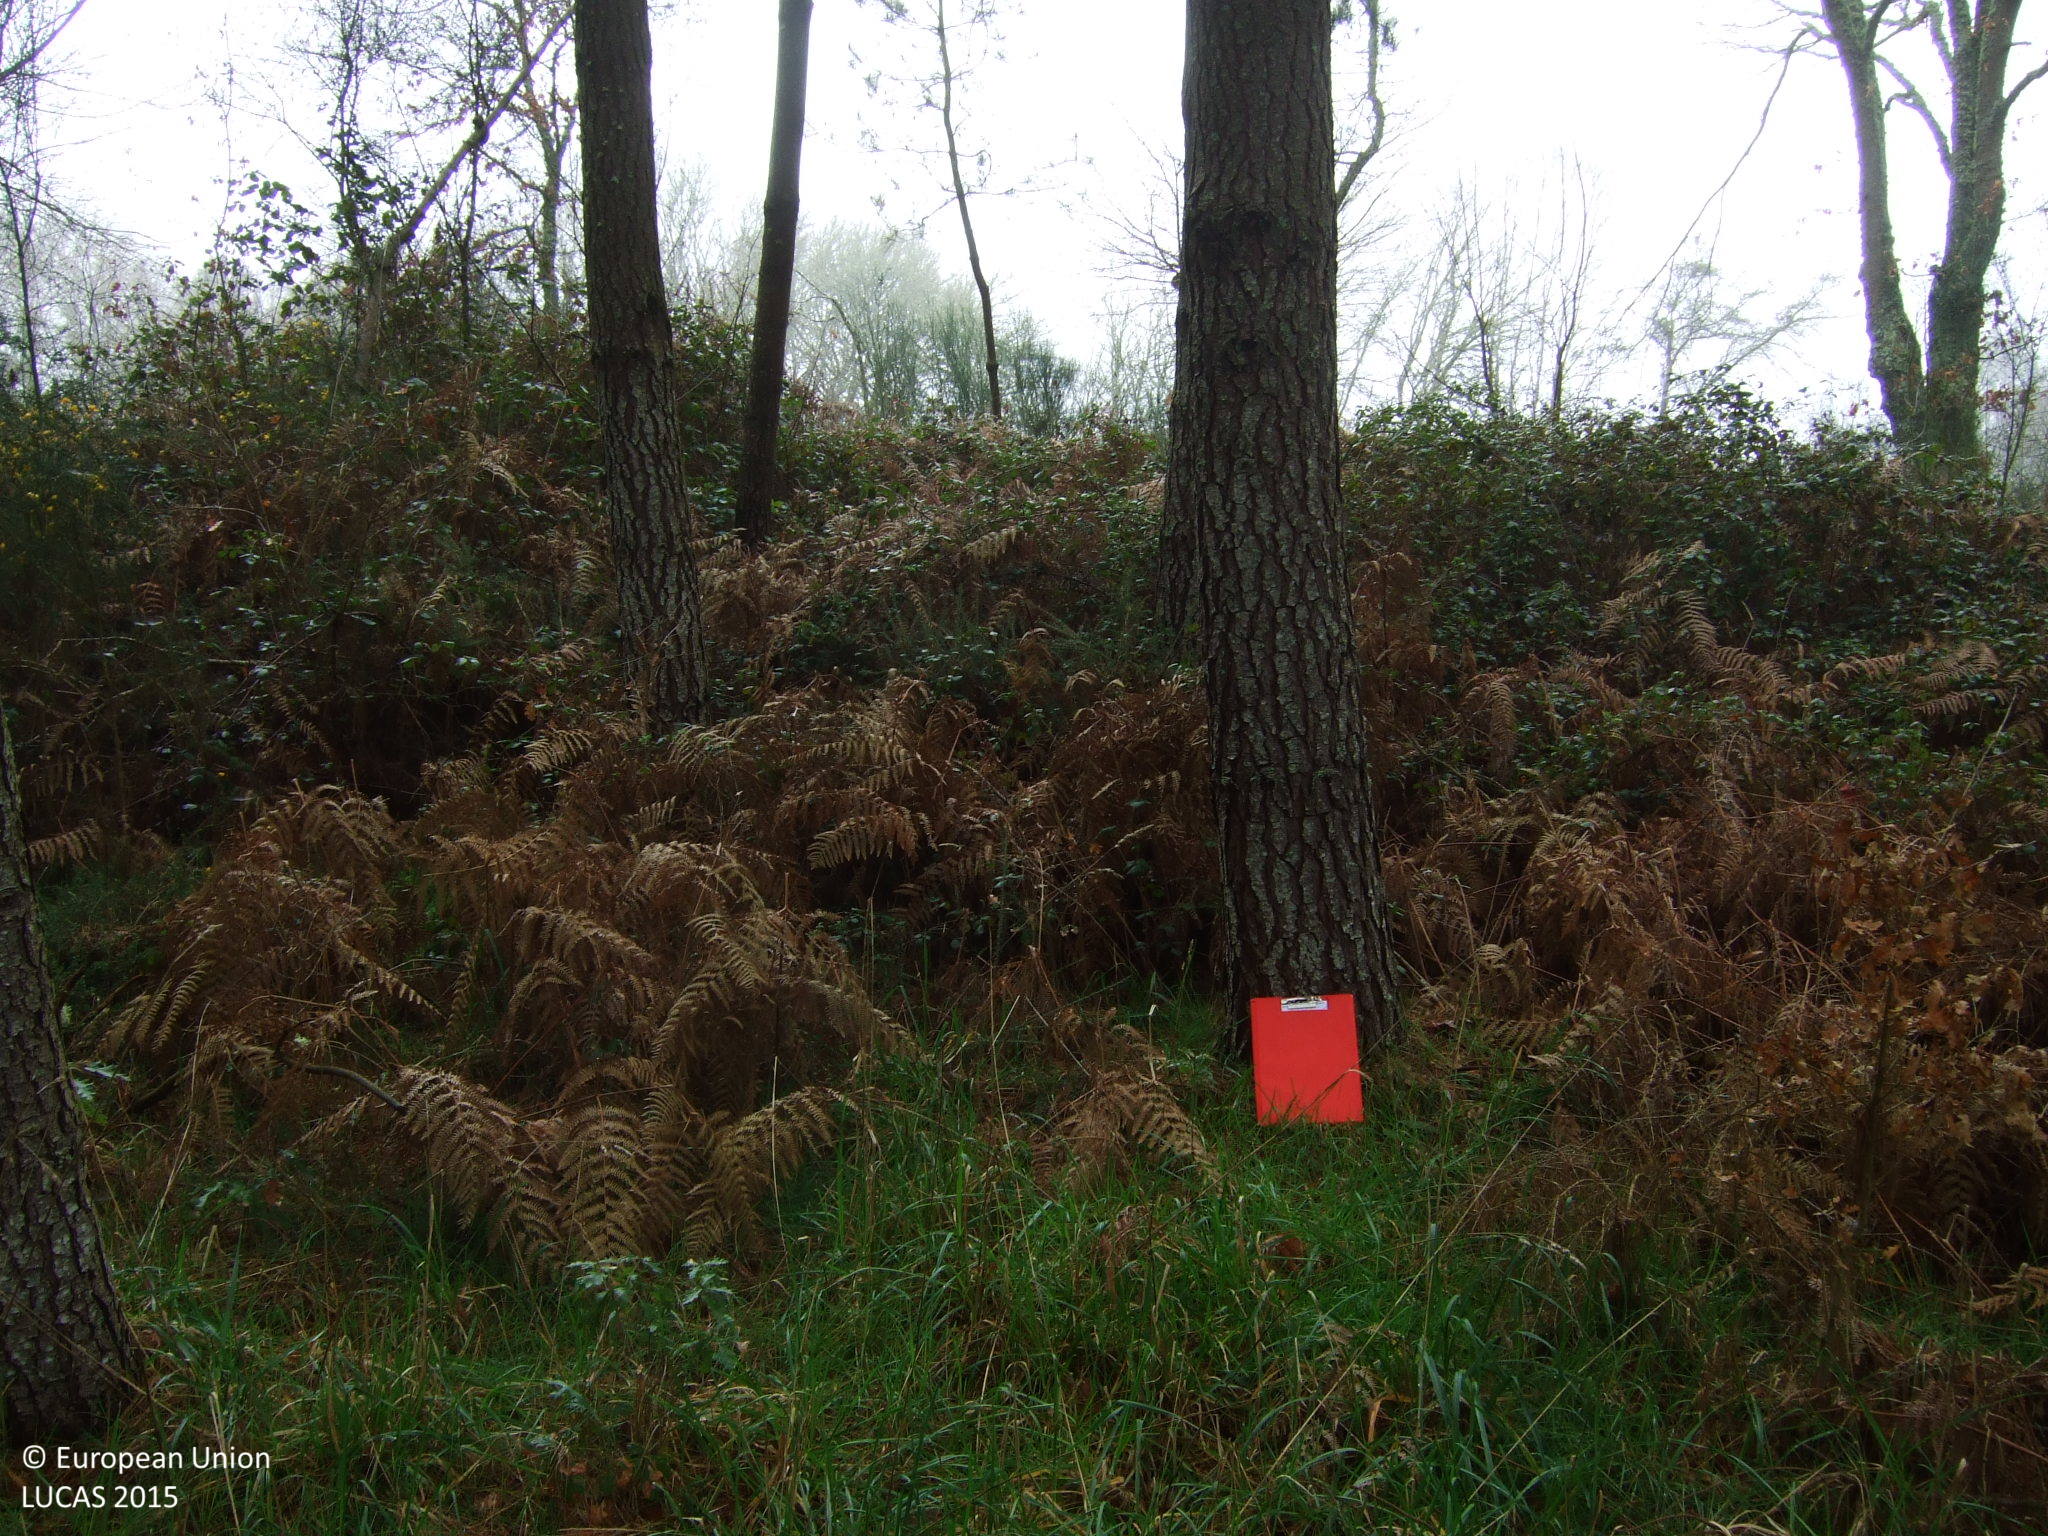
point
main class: Woodland
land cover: Pine dominated coniferous woodland
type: exotic forest
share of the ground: > 75 %
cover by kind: coniferous forest trees 90 %, shrubs 10 %
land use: Forestry
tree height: > 5 m
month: March
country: ES
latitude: 42.8014
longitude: -7.8745
